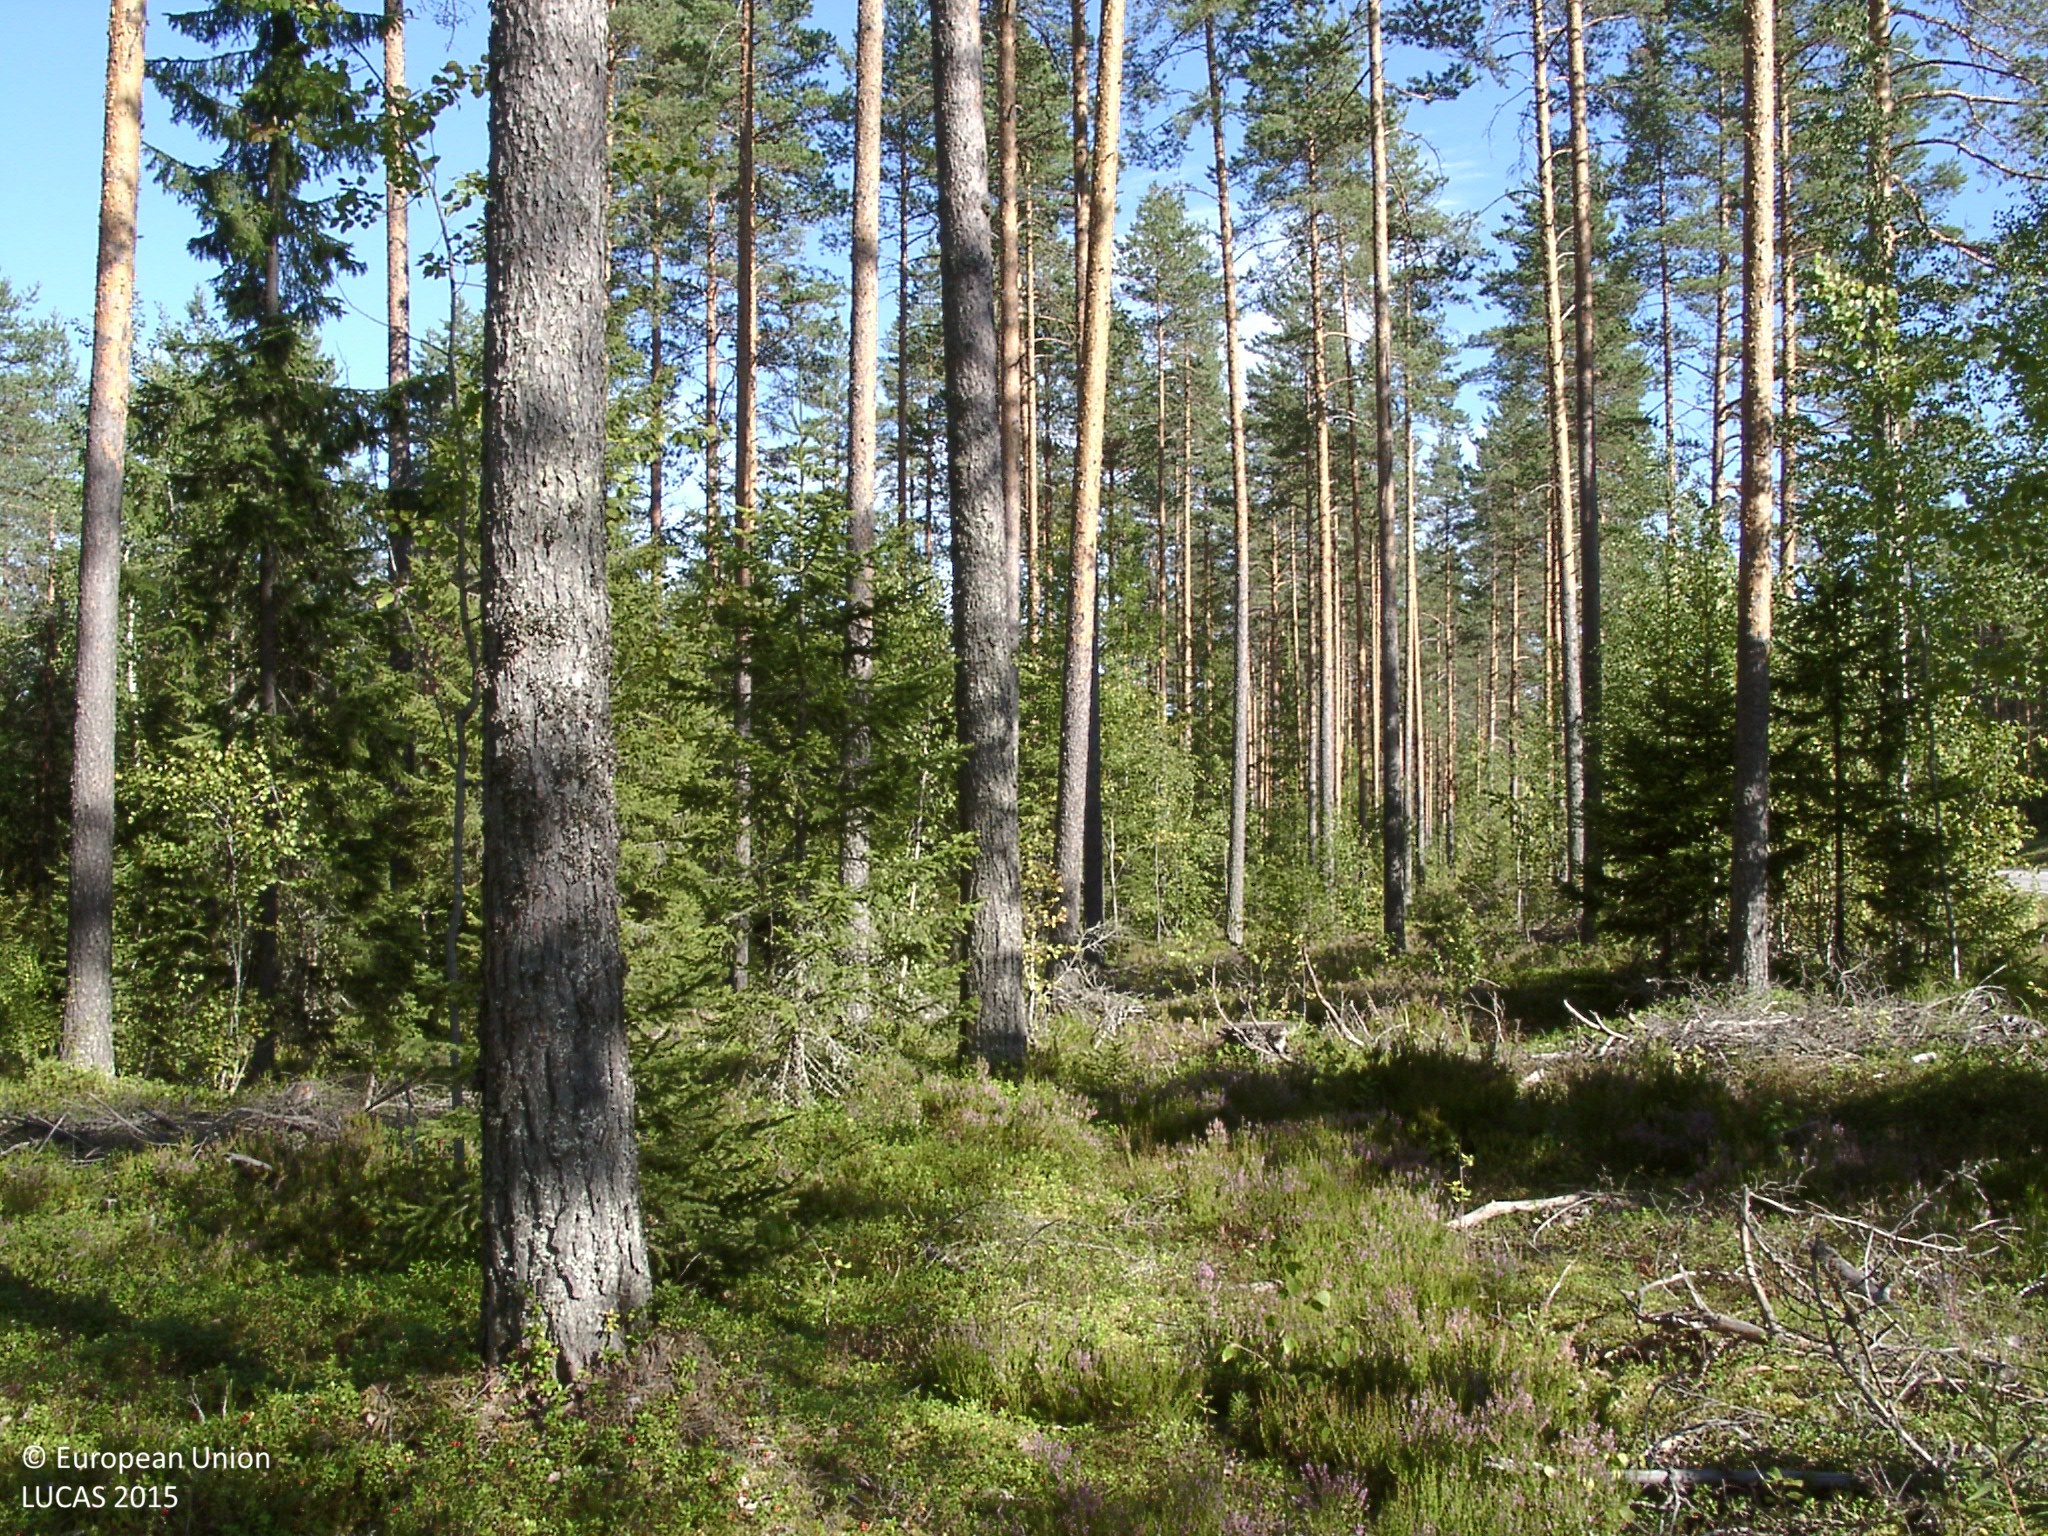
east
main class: Woodland
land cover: Pine dominated coniferous woodland
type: boreal forest
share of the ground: 50 - 75 %
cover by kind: coniferous forest trees 45 %, shrubs 30 %, broadleaved forest trees 10 %, lichens and mosses 10 %
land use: Forestry
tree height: > 5 m
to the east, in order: Pine dominated coniferous woodland; Other coniferous woodland; Tracks; Other mixed woodland; Ditches and canals; Other mixed woodland; Ditches and canals; Pine dominated mixed woodland; Pine dominated coniferous woodland; Ditches and canals; Pine dominated coniferous woodland; Ditches and canals; Pine dominated coniferous woodland; Ditches and canals; Pine dominated coniferous woodland; Ditches and canals
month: August
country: FI
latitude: 61.8873
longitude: 25.0404
